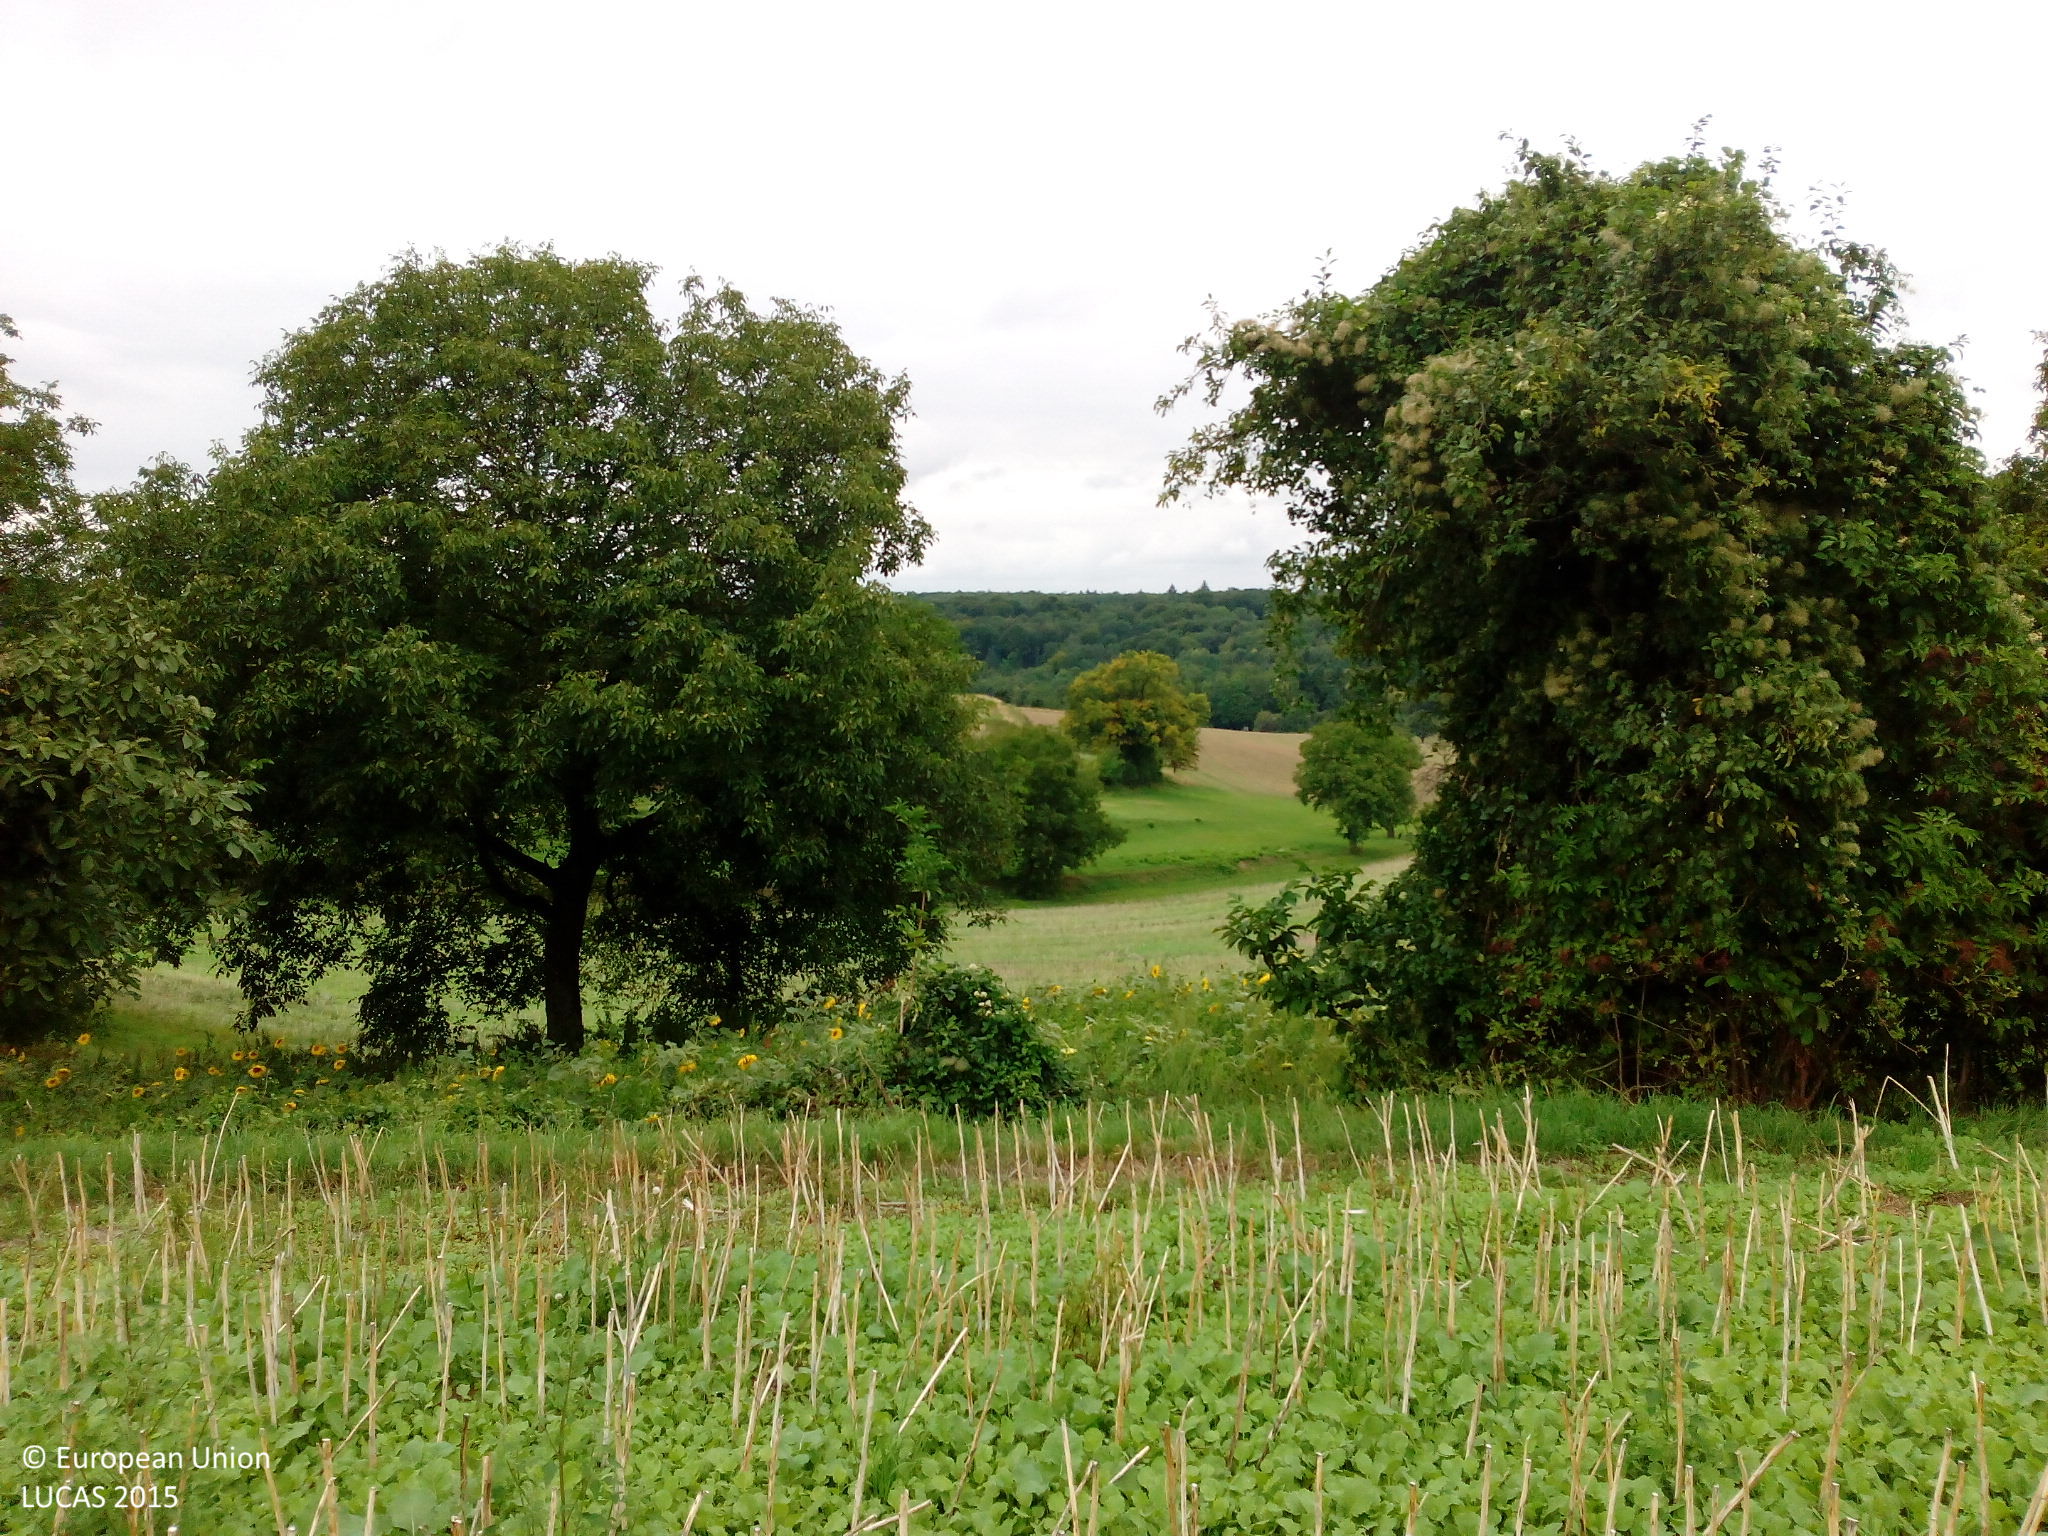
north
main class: Cropland
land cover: Rape and turnip rape
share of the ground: 10 - 25 %
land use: Agriculture (excluding fallow land and kitchen gardens)
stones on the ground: < 10 %
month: August
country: DE
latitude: 49.0599
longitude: 8.5636
